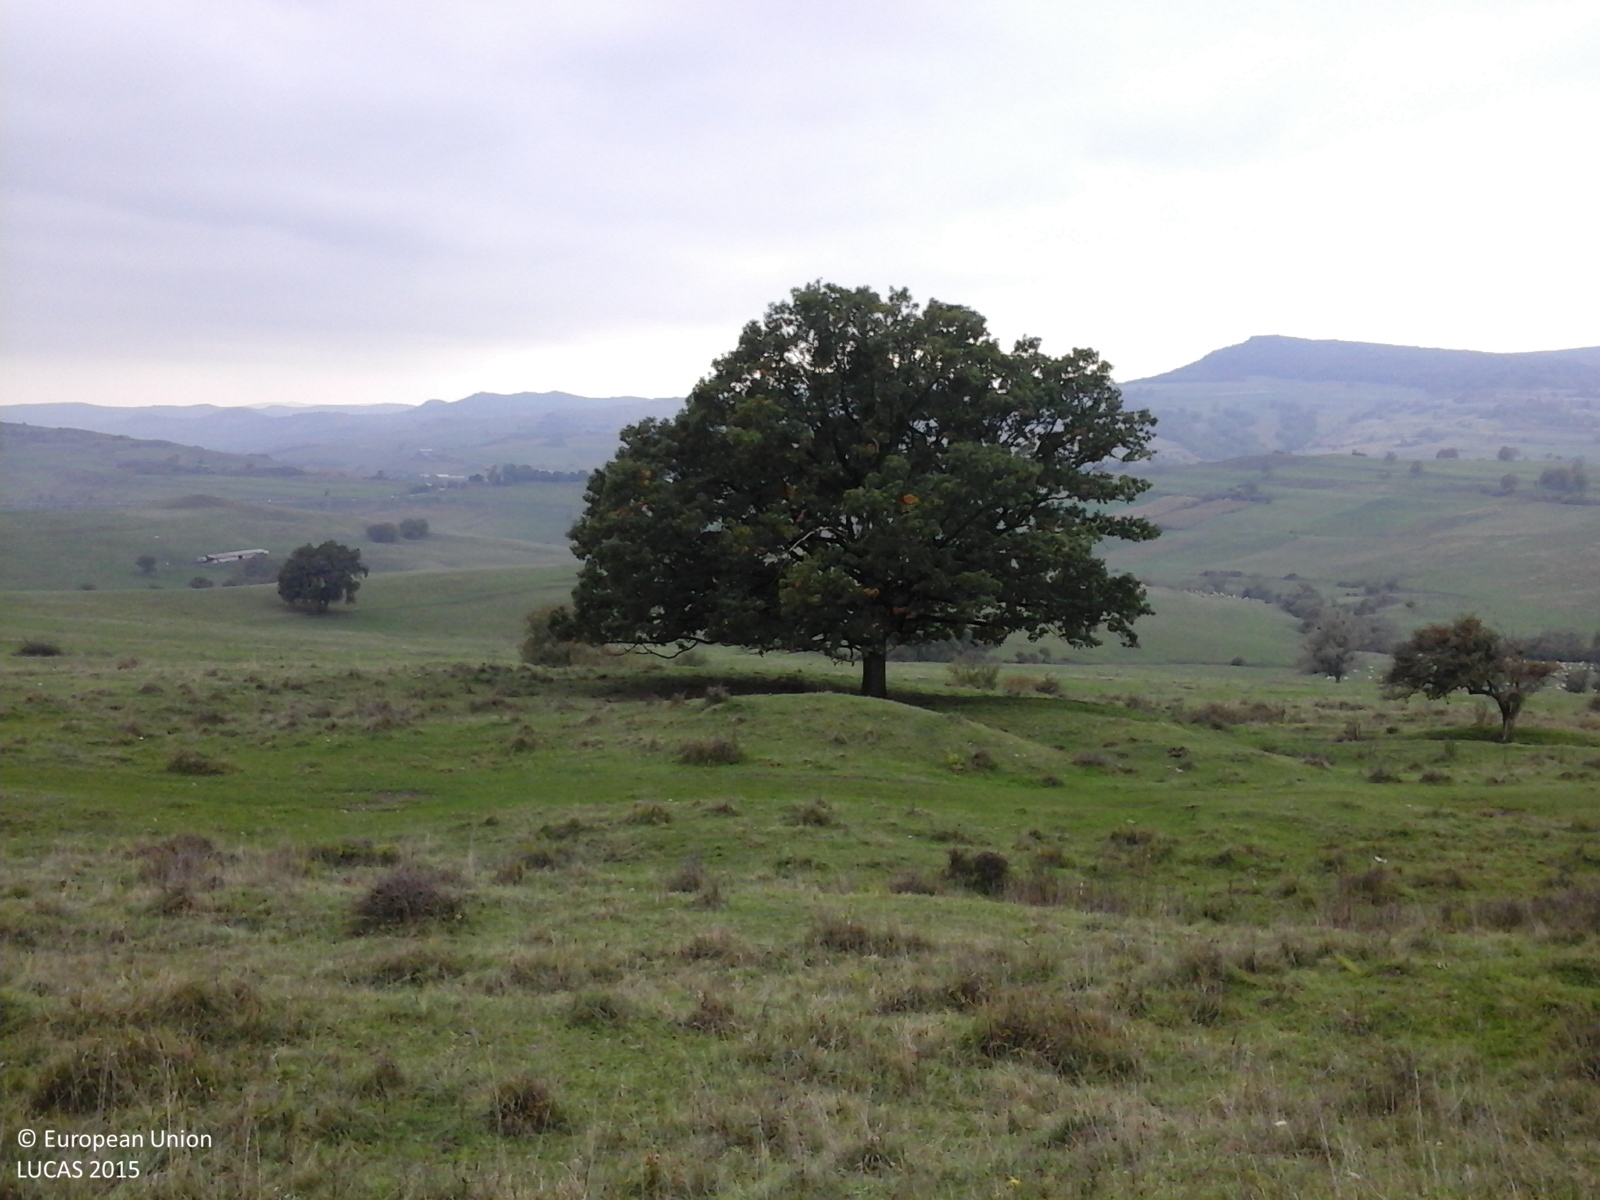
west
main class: Grassland
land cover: Grassland without tree/shrub cover
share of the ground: > 75 %
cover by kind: herbaceous plants 100 %
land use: Agriculture (excluding fallow land and kitchen gardens)
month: October
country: RO
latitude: 46.2672
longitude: 24.7919
